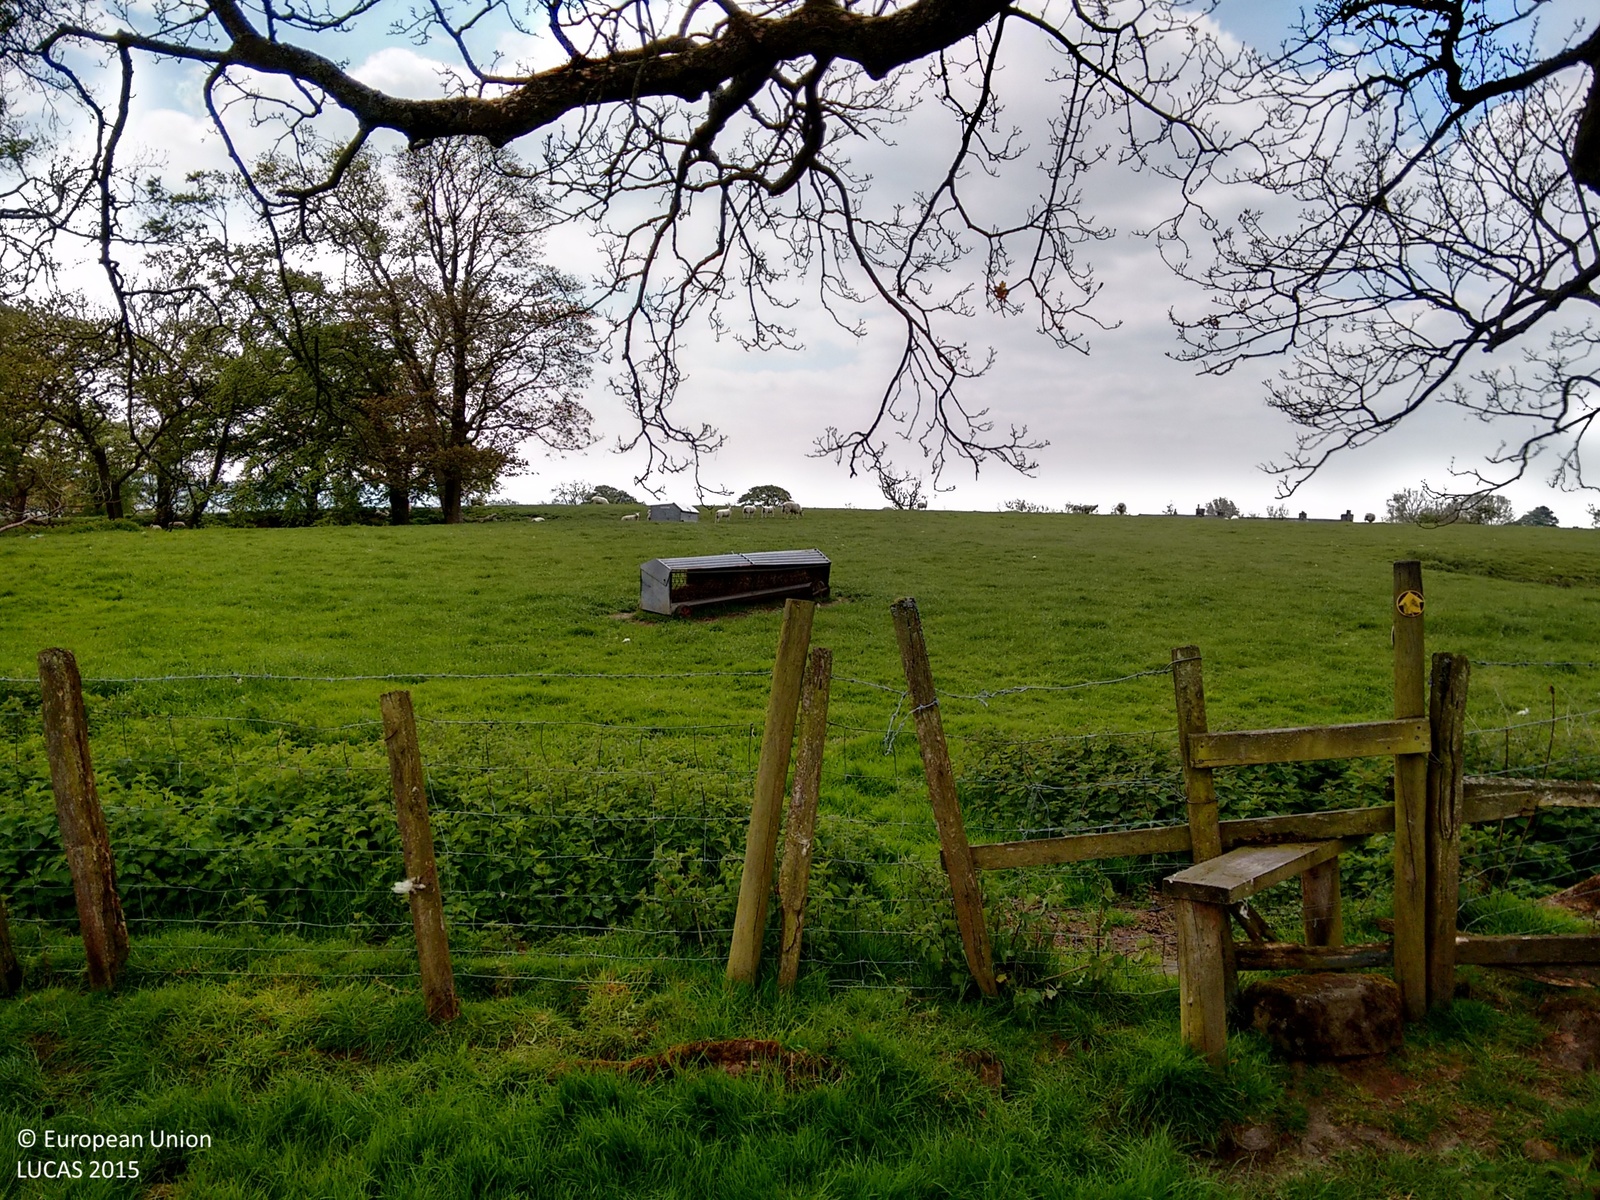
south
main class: Grassland
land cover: Grassland without tree/shrub cover
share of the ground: > 75 %
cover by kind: herbaceous plants 100 %
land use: Agriculture (excluding fallow land and kitchen gardens)
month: May
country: GB
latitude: 53.8359
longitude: -2.5724
